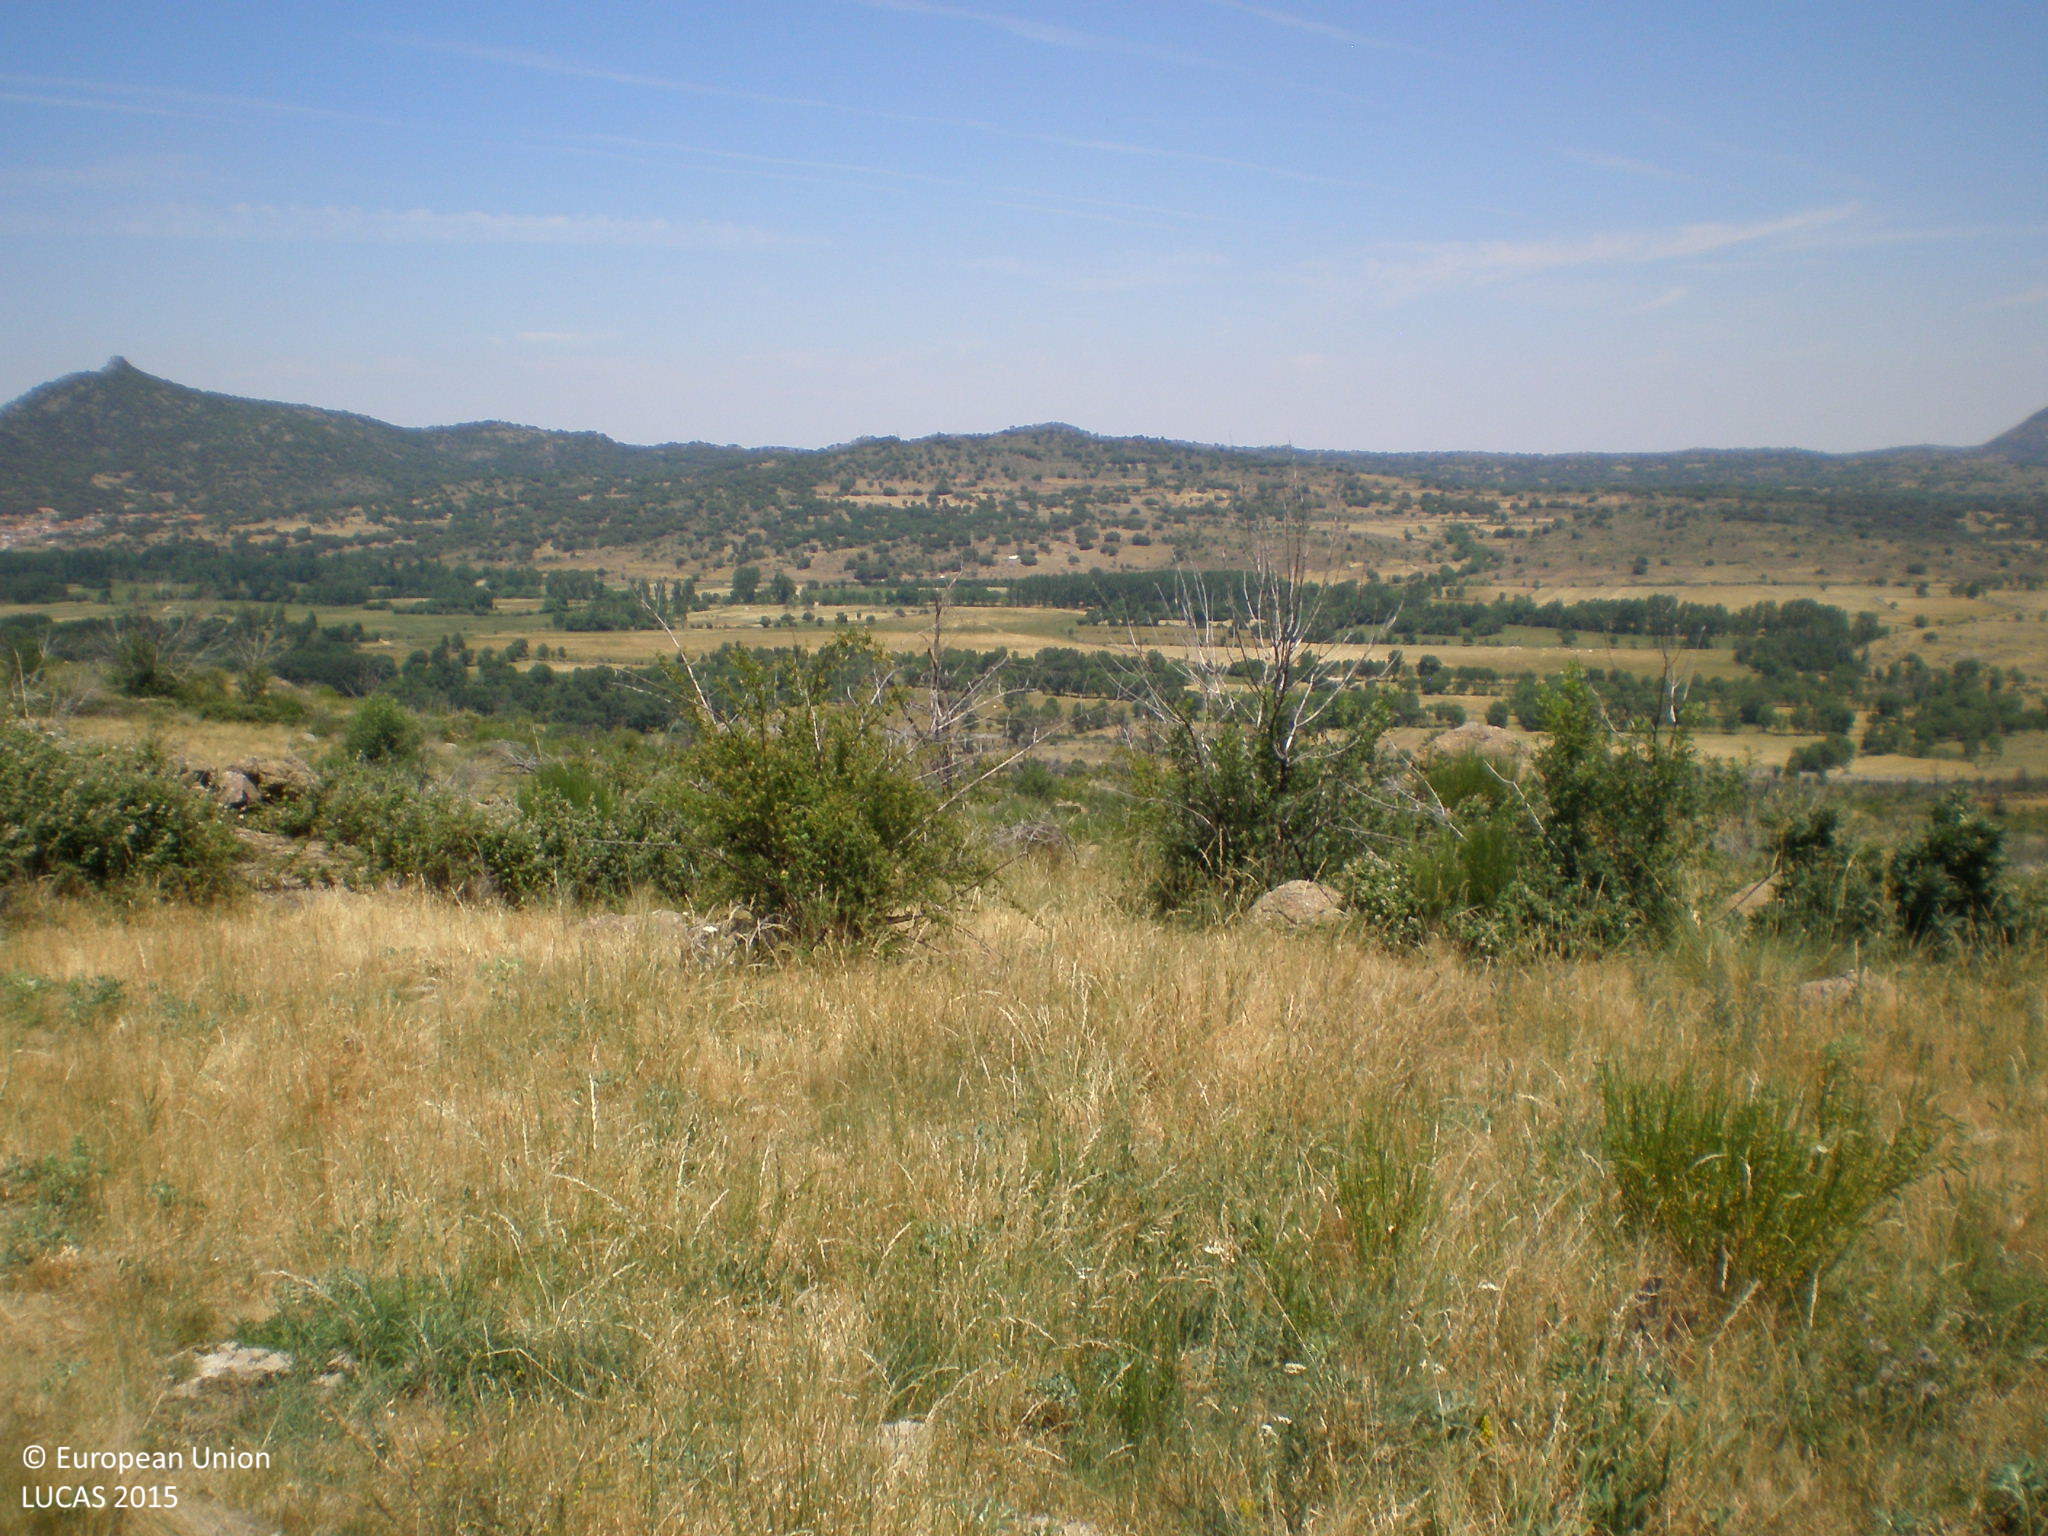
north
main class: Shrubland
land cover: Shrubland without tree cover
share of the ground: 50 - 75 %
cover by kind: shrubs 70 %, herbaceous plants 30 %
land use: Semi-natural and natural areas not in use
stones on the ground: < 10 %
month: June
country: ES
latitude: 40.3924
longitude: -5.5828
